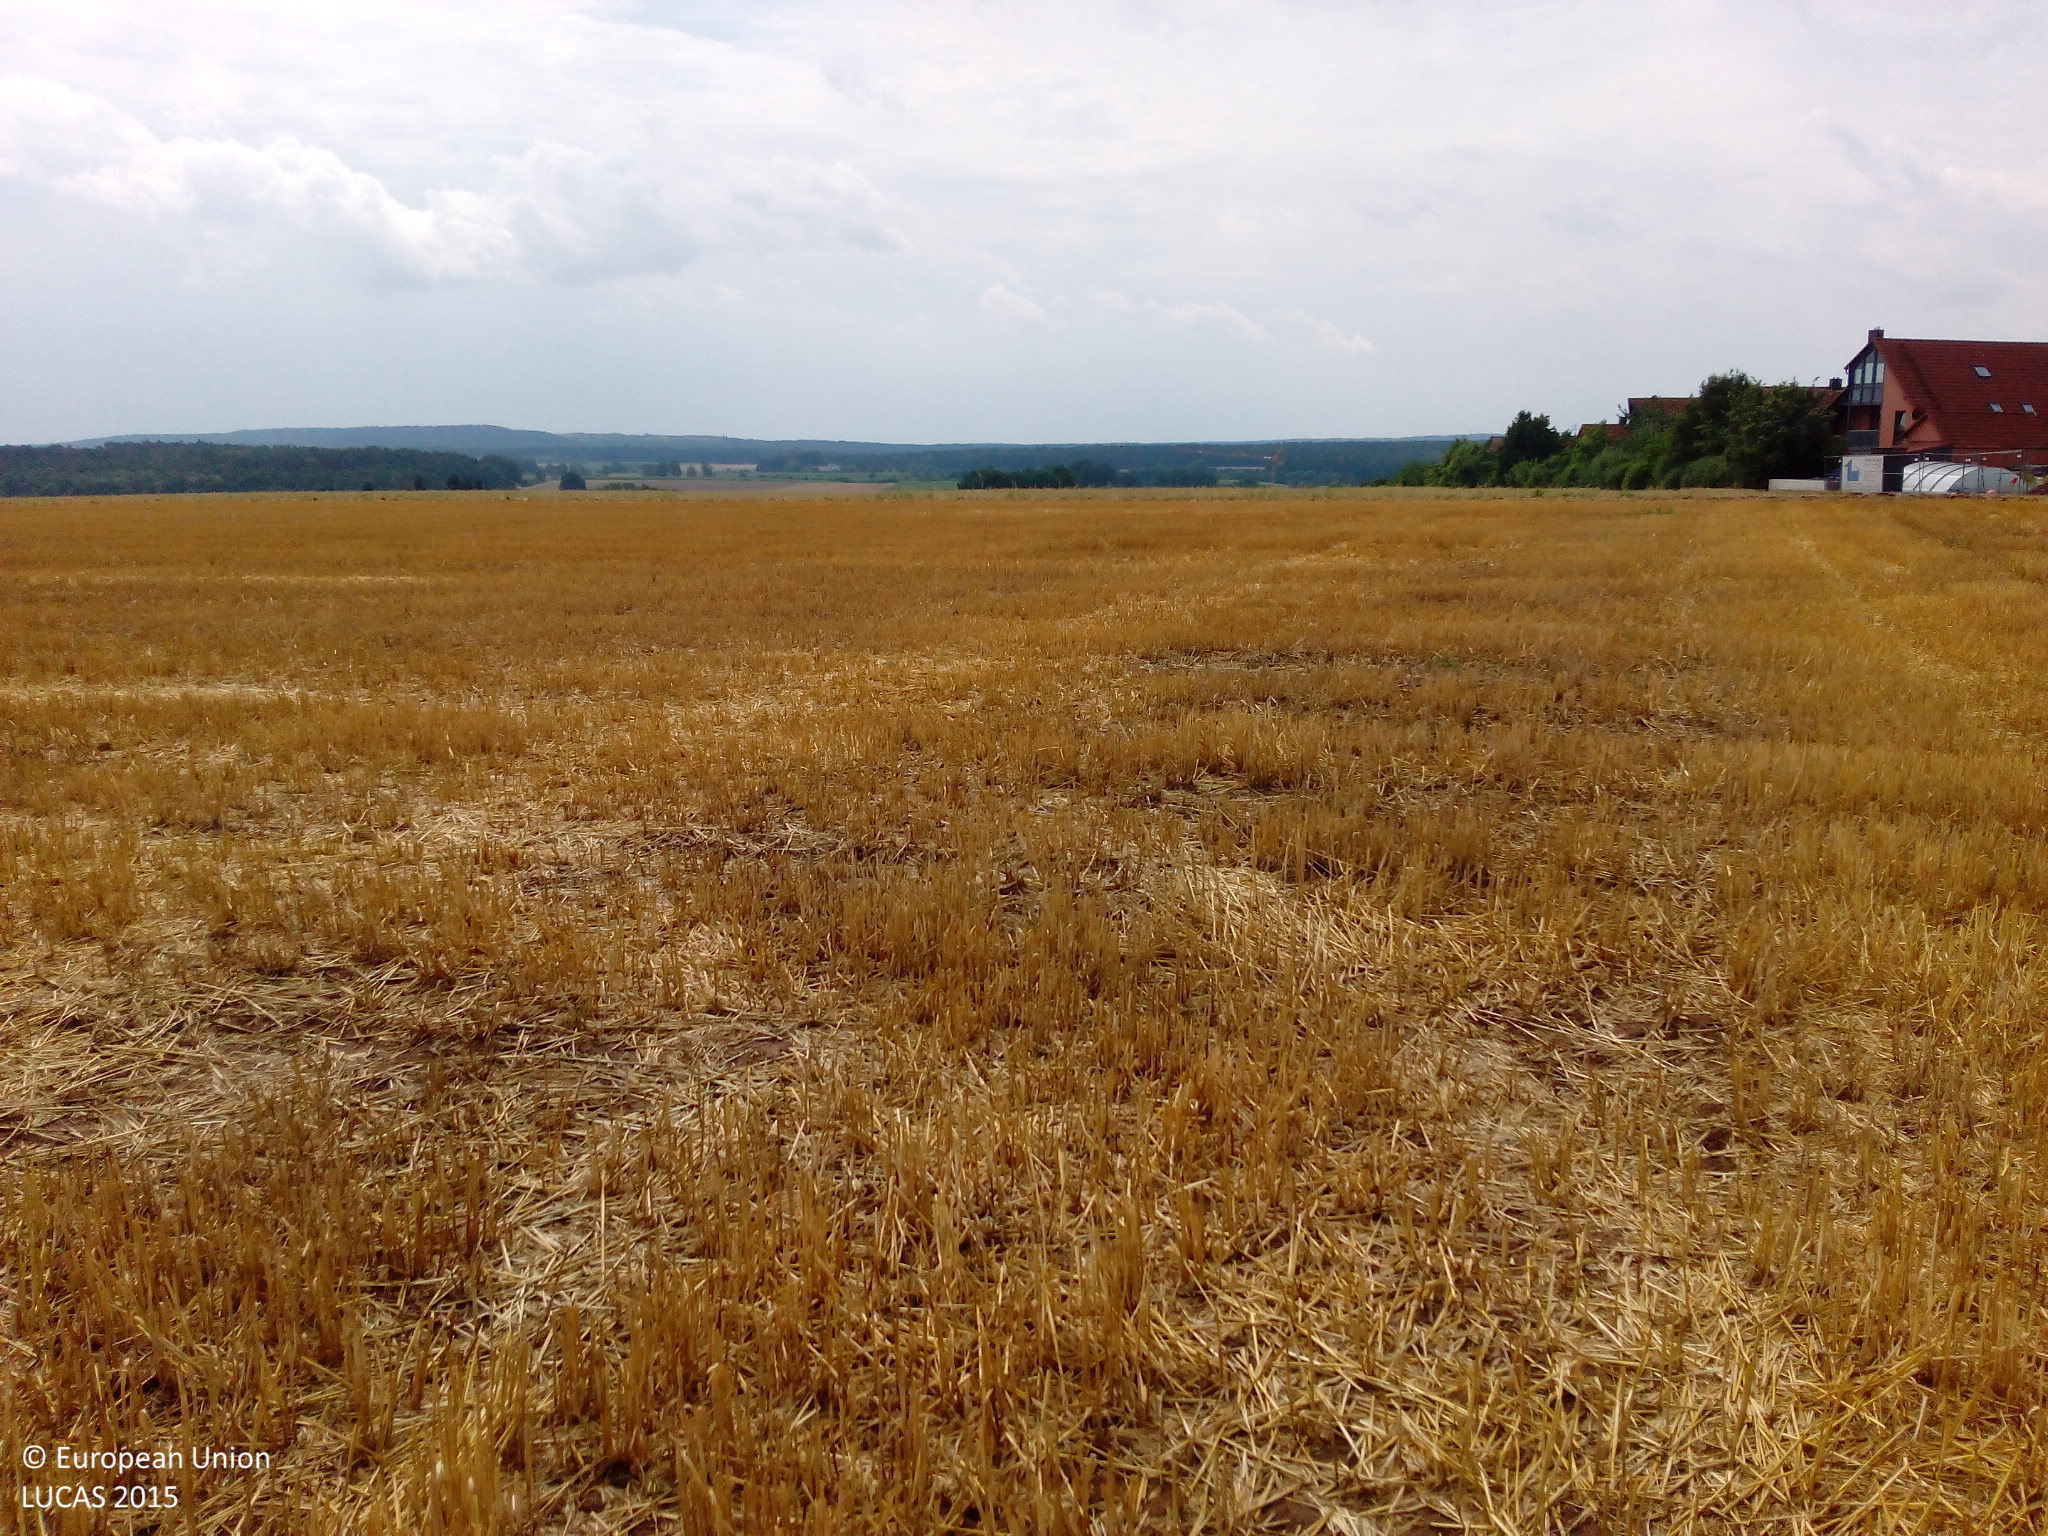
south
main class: Cropland
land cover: Barley
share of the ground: 25 - 50 %
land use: Agriculture (excluding fallow land and kitchen gardens)
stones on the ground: < 10 %
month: July
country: DE
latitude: 49.5153
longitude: 10.8975
